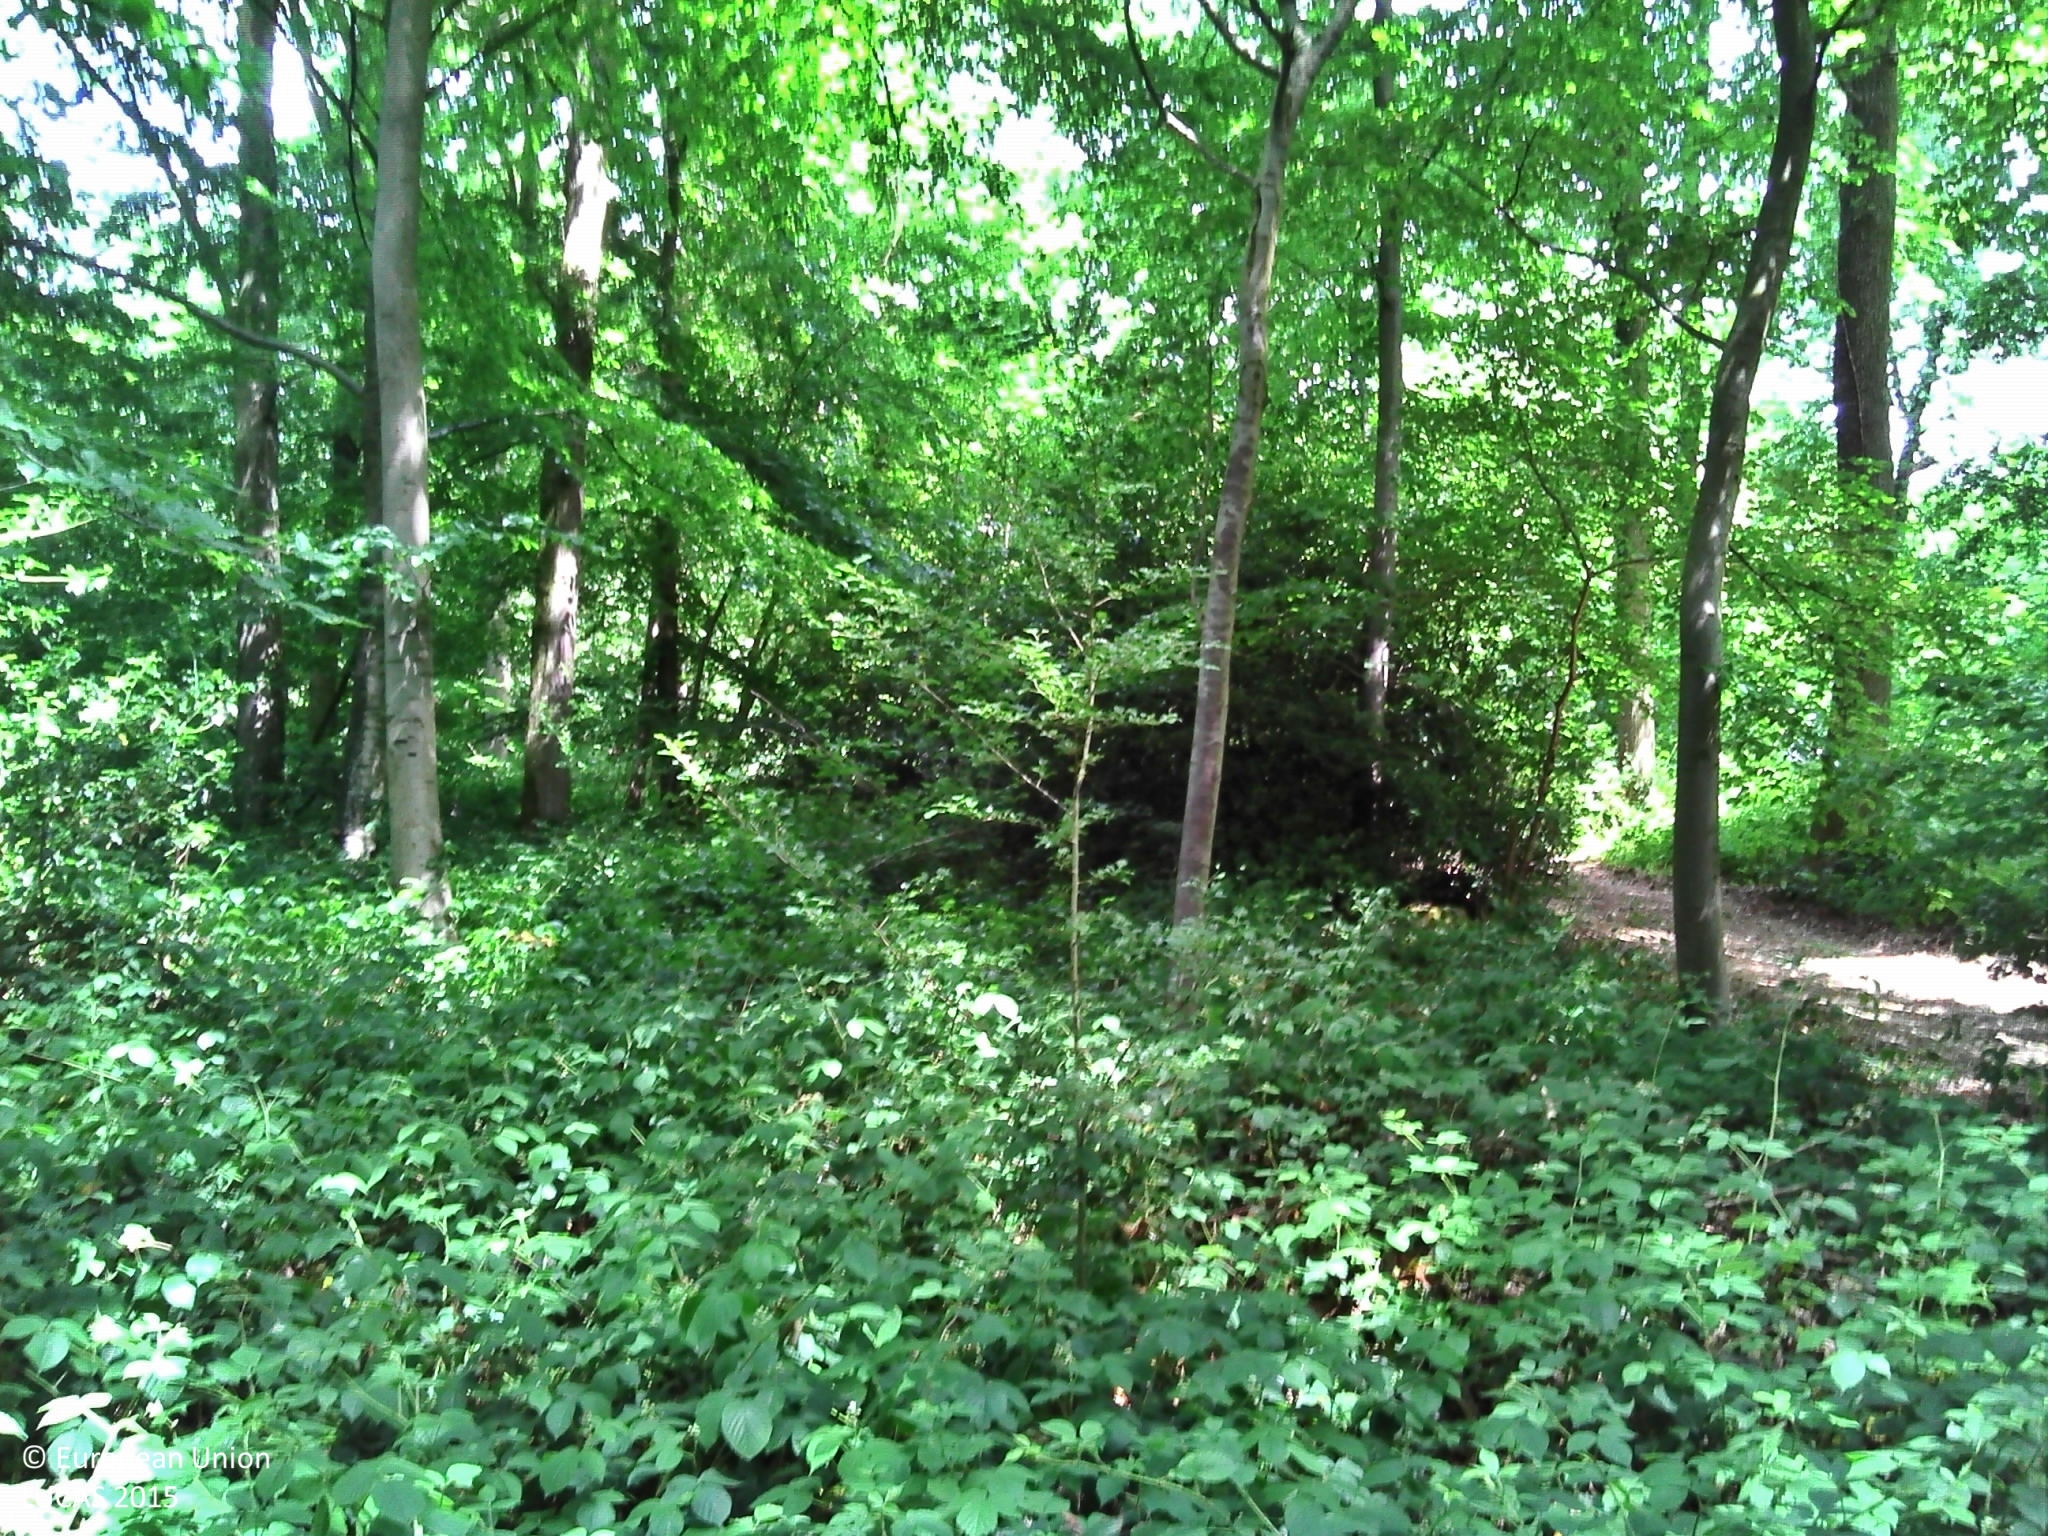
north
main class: Woodland
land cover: Broadleaved woodland
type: beech forest
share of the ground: > 75 %
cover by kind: broadleaved forest trees 80 %, herbaceous plants 15 %, shrubs 5 %
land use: Forestry
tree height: > 5 m
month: June
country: FR
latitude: 49.5218
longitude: 2.2367
